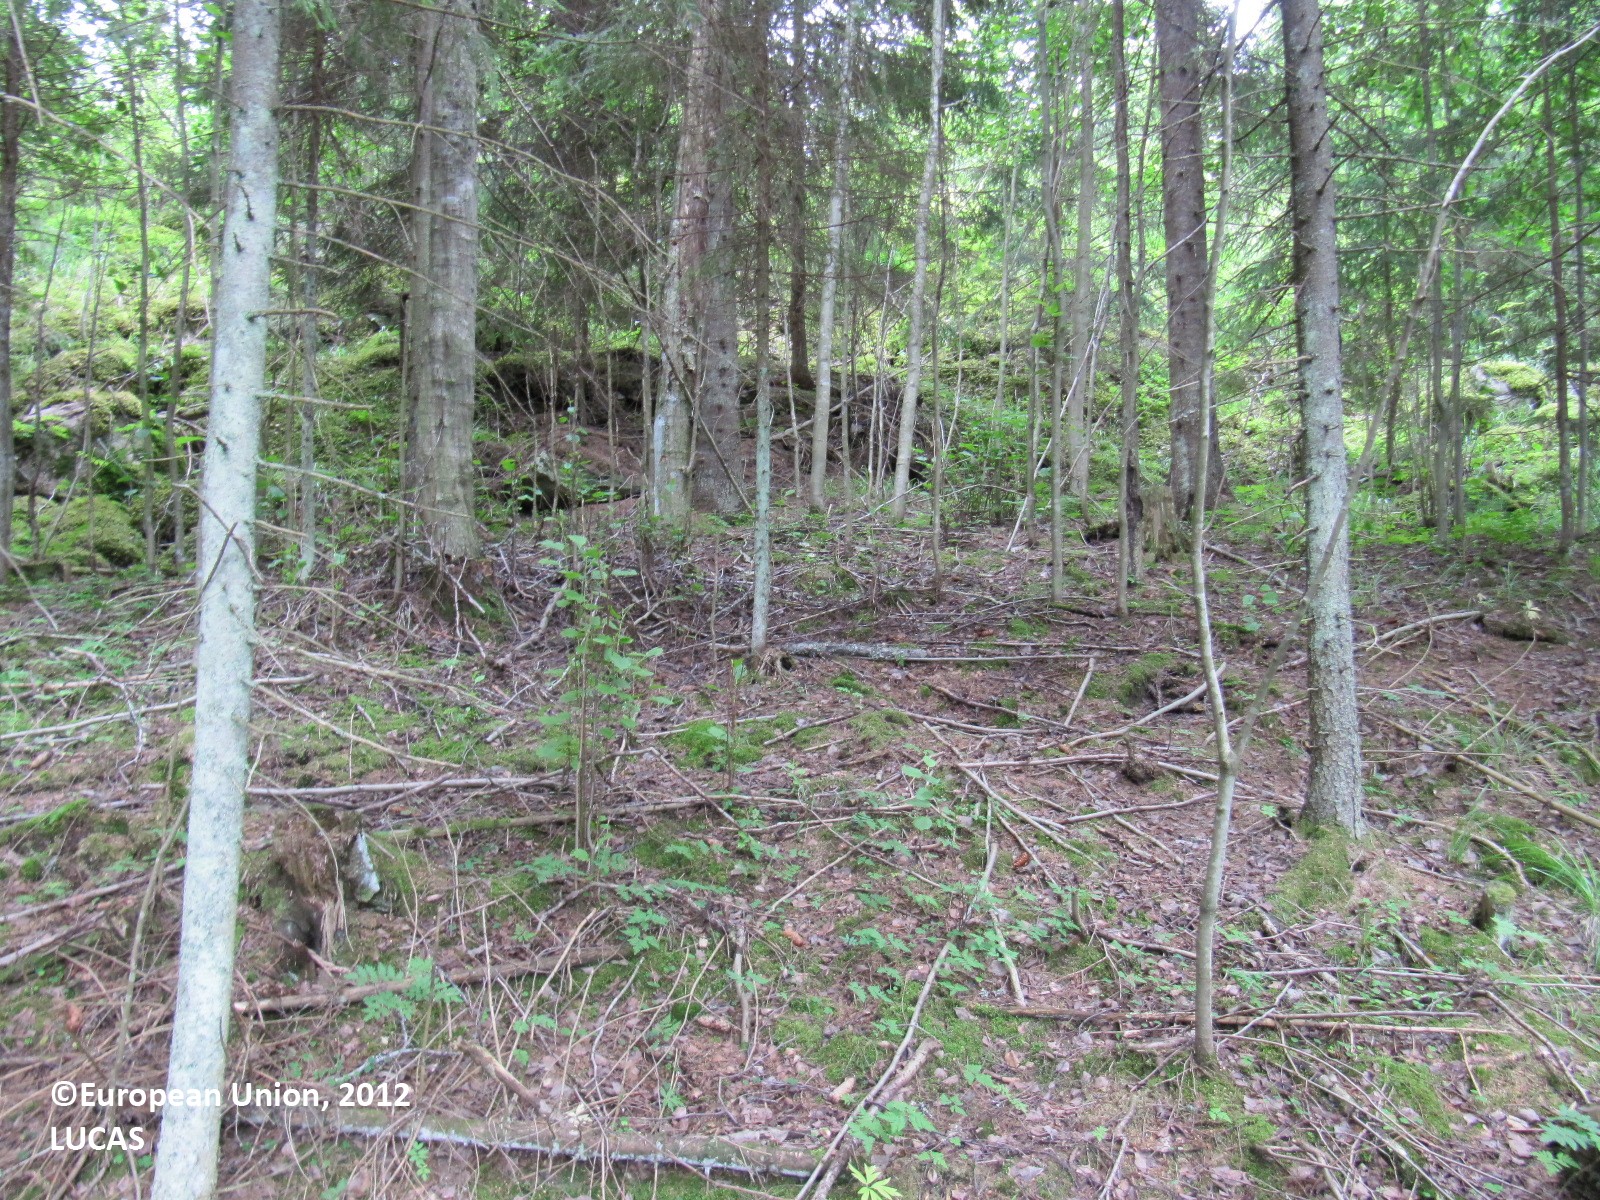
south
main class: Woodland
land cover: Spruce dominated mixed woodland
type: boreal forest
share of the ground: > 75 %
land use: Forestry
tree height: > 5 m
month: July
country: FI
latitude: 60.8309
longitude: 24.5810
